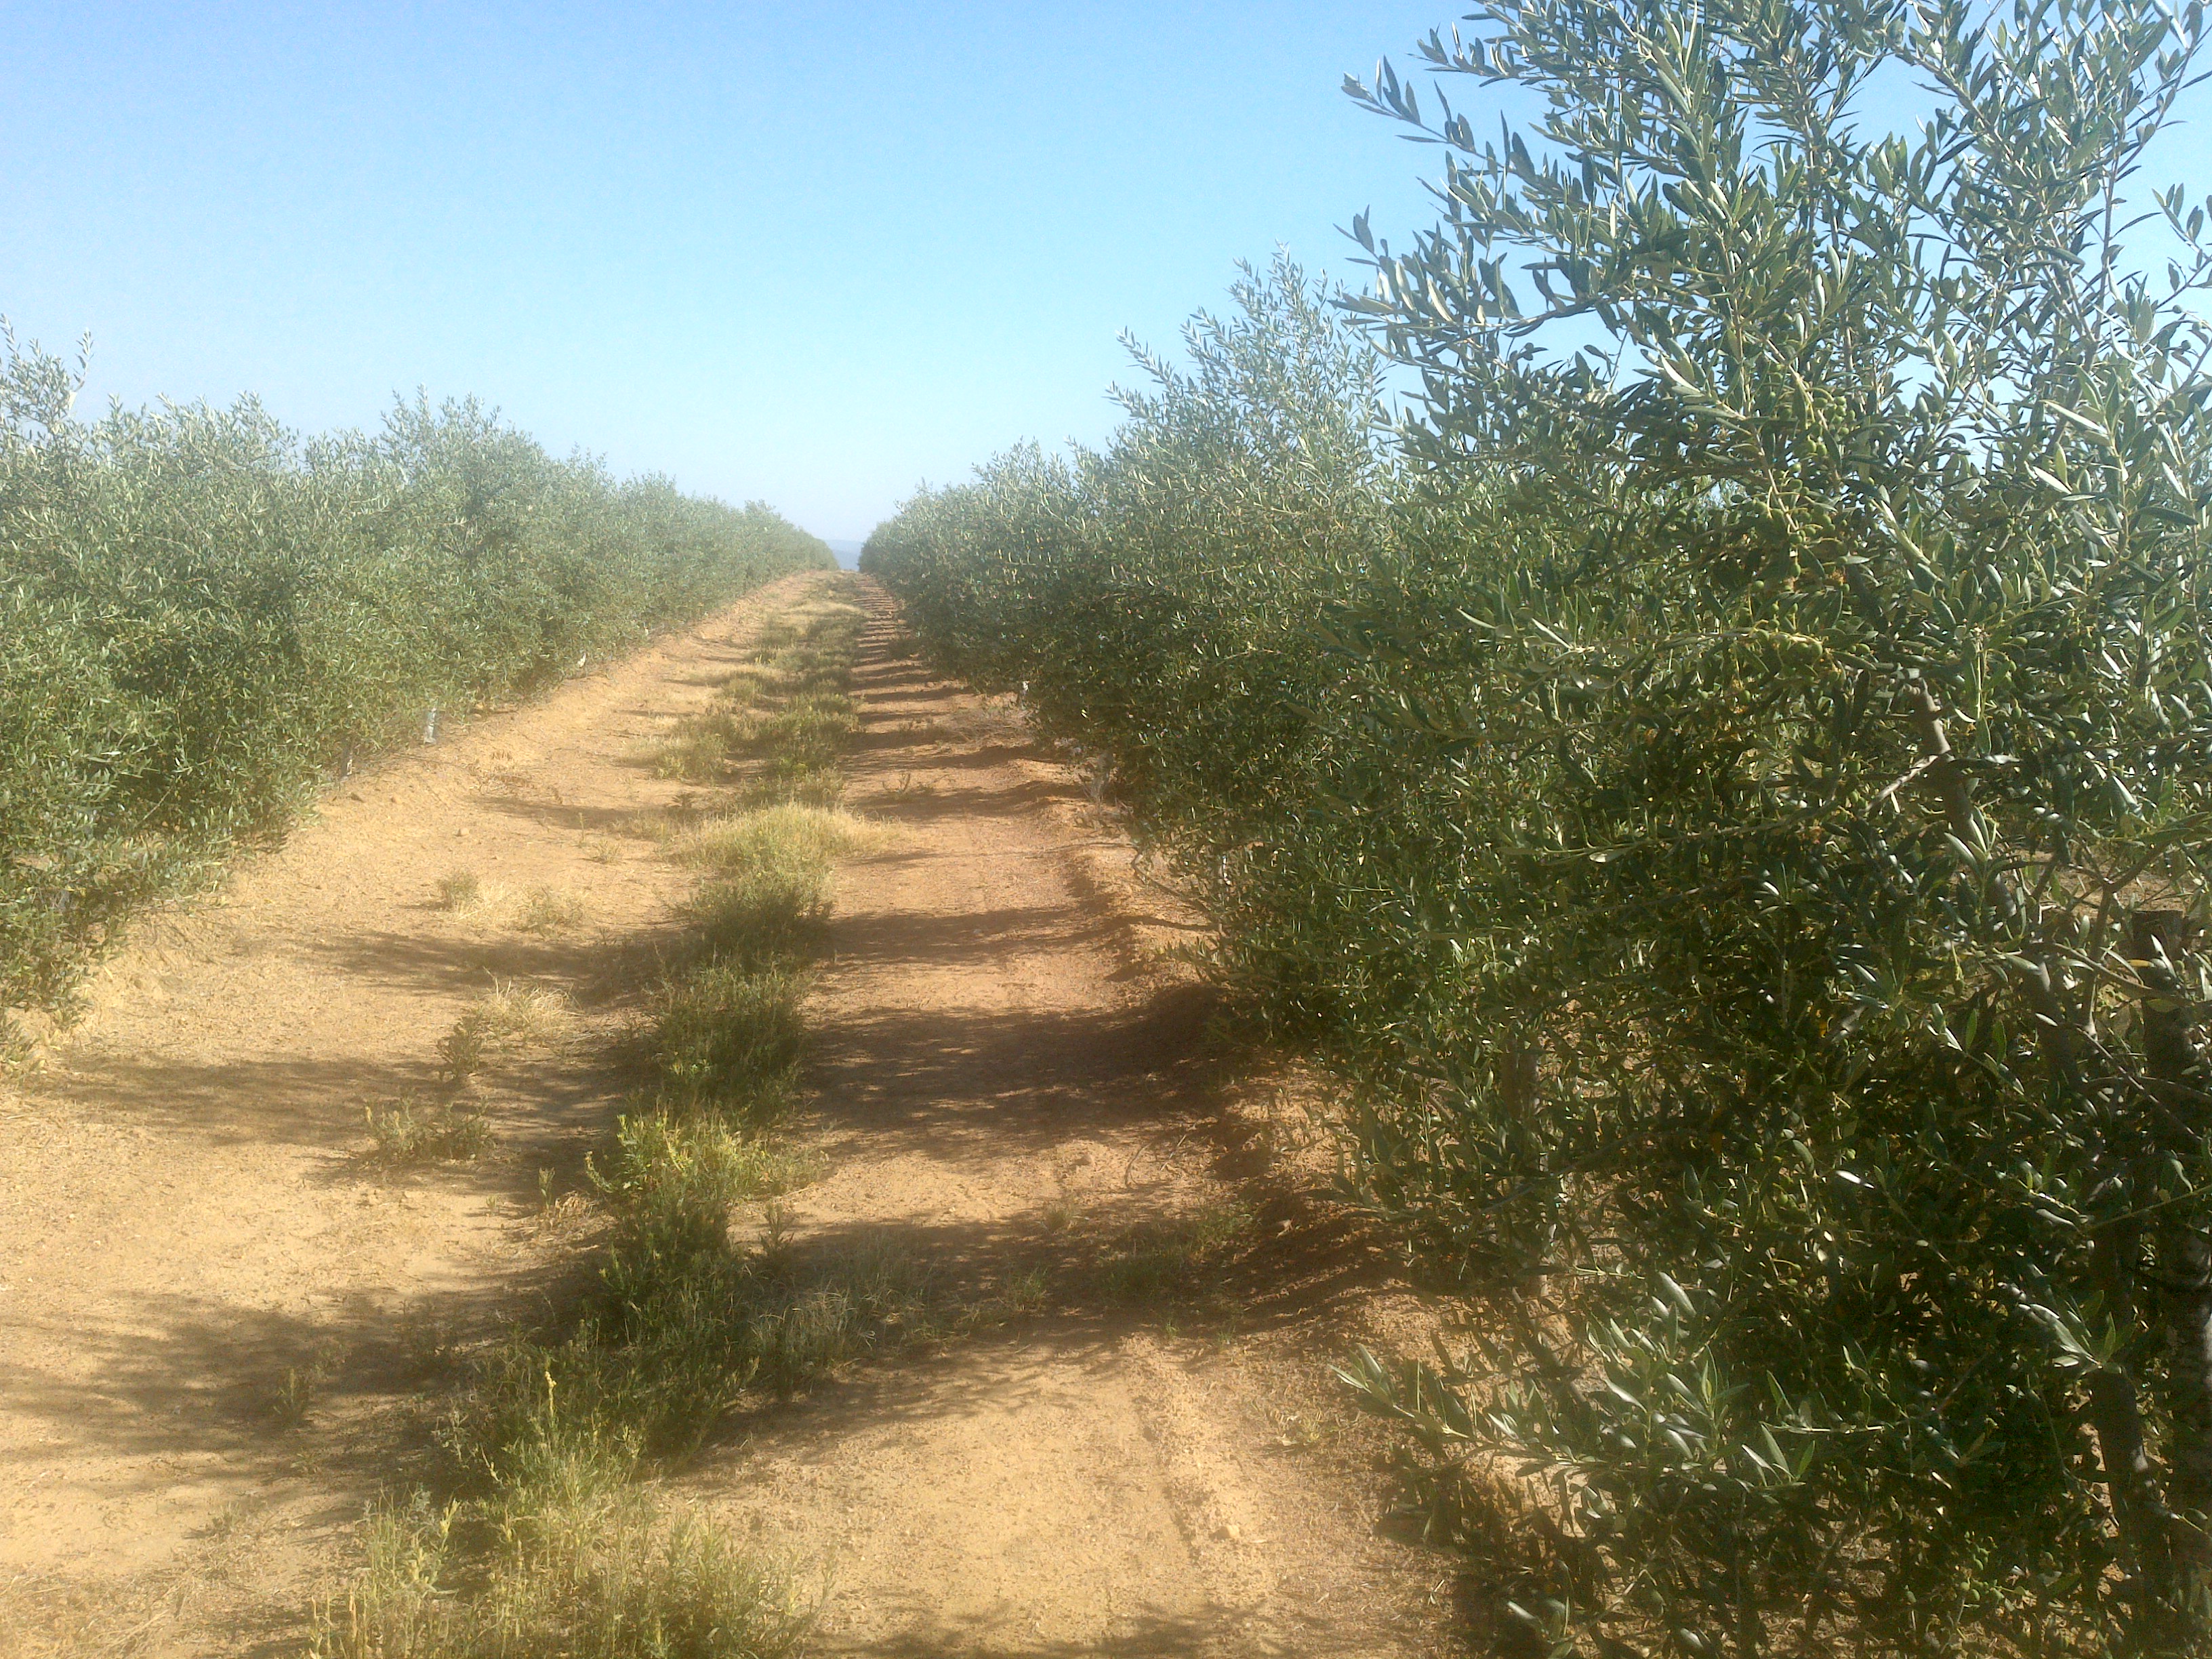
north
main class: Cropland
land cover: Olive groves
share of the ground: 25 - 50 %
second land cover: Spontaneously vegetated surfaces
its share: 10 - 25 %
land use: Agriculture (excluding fallow land and kitchen gardens)
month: June
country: ES
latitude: 37.6850
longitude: -5.1545
